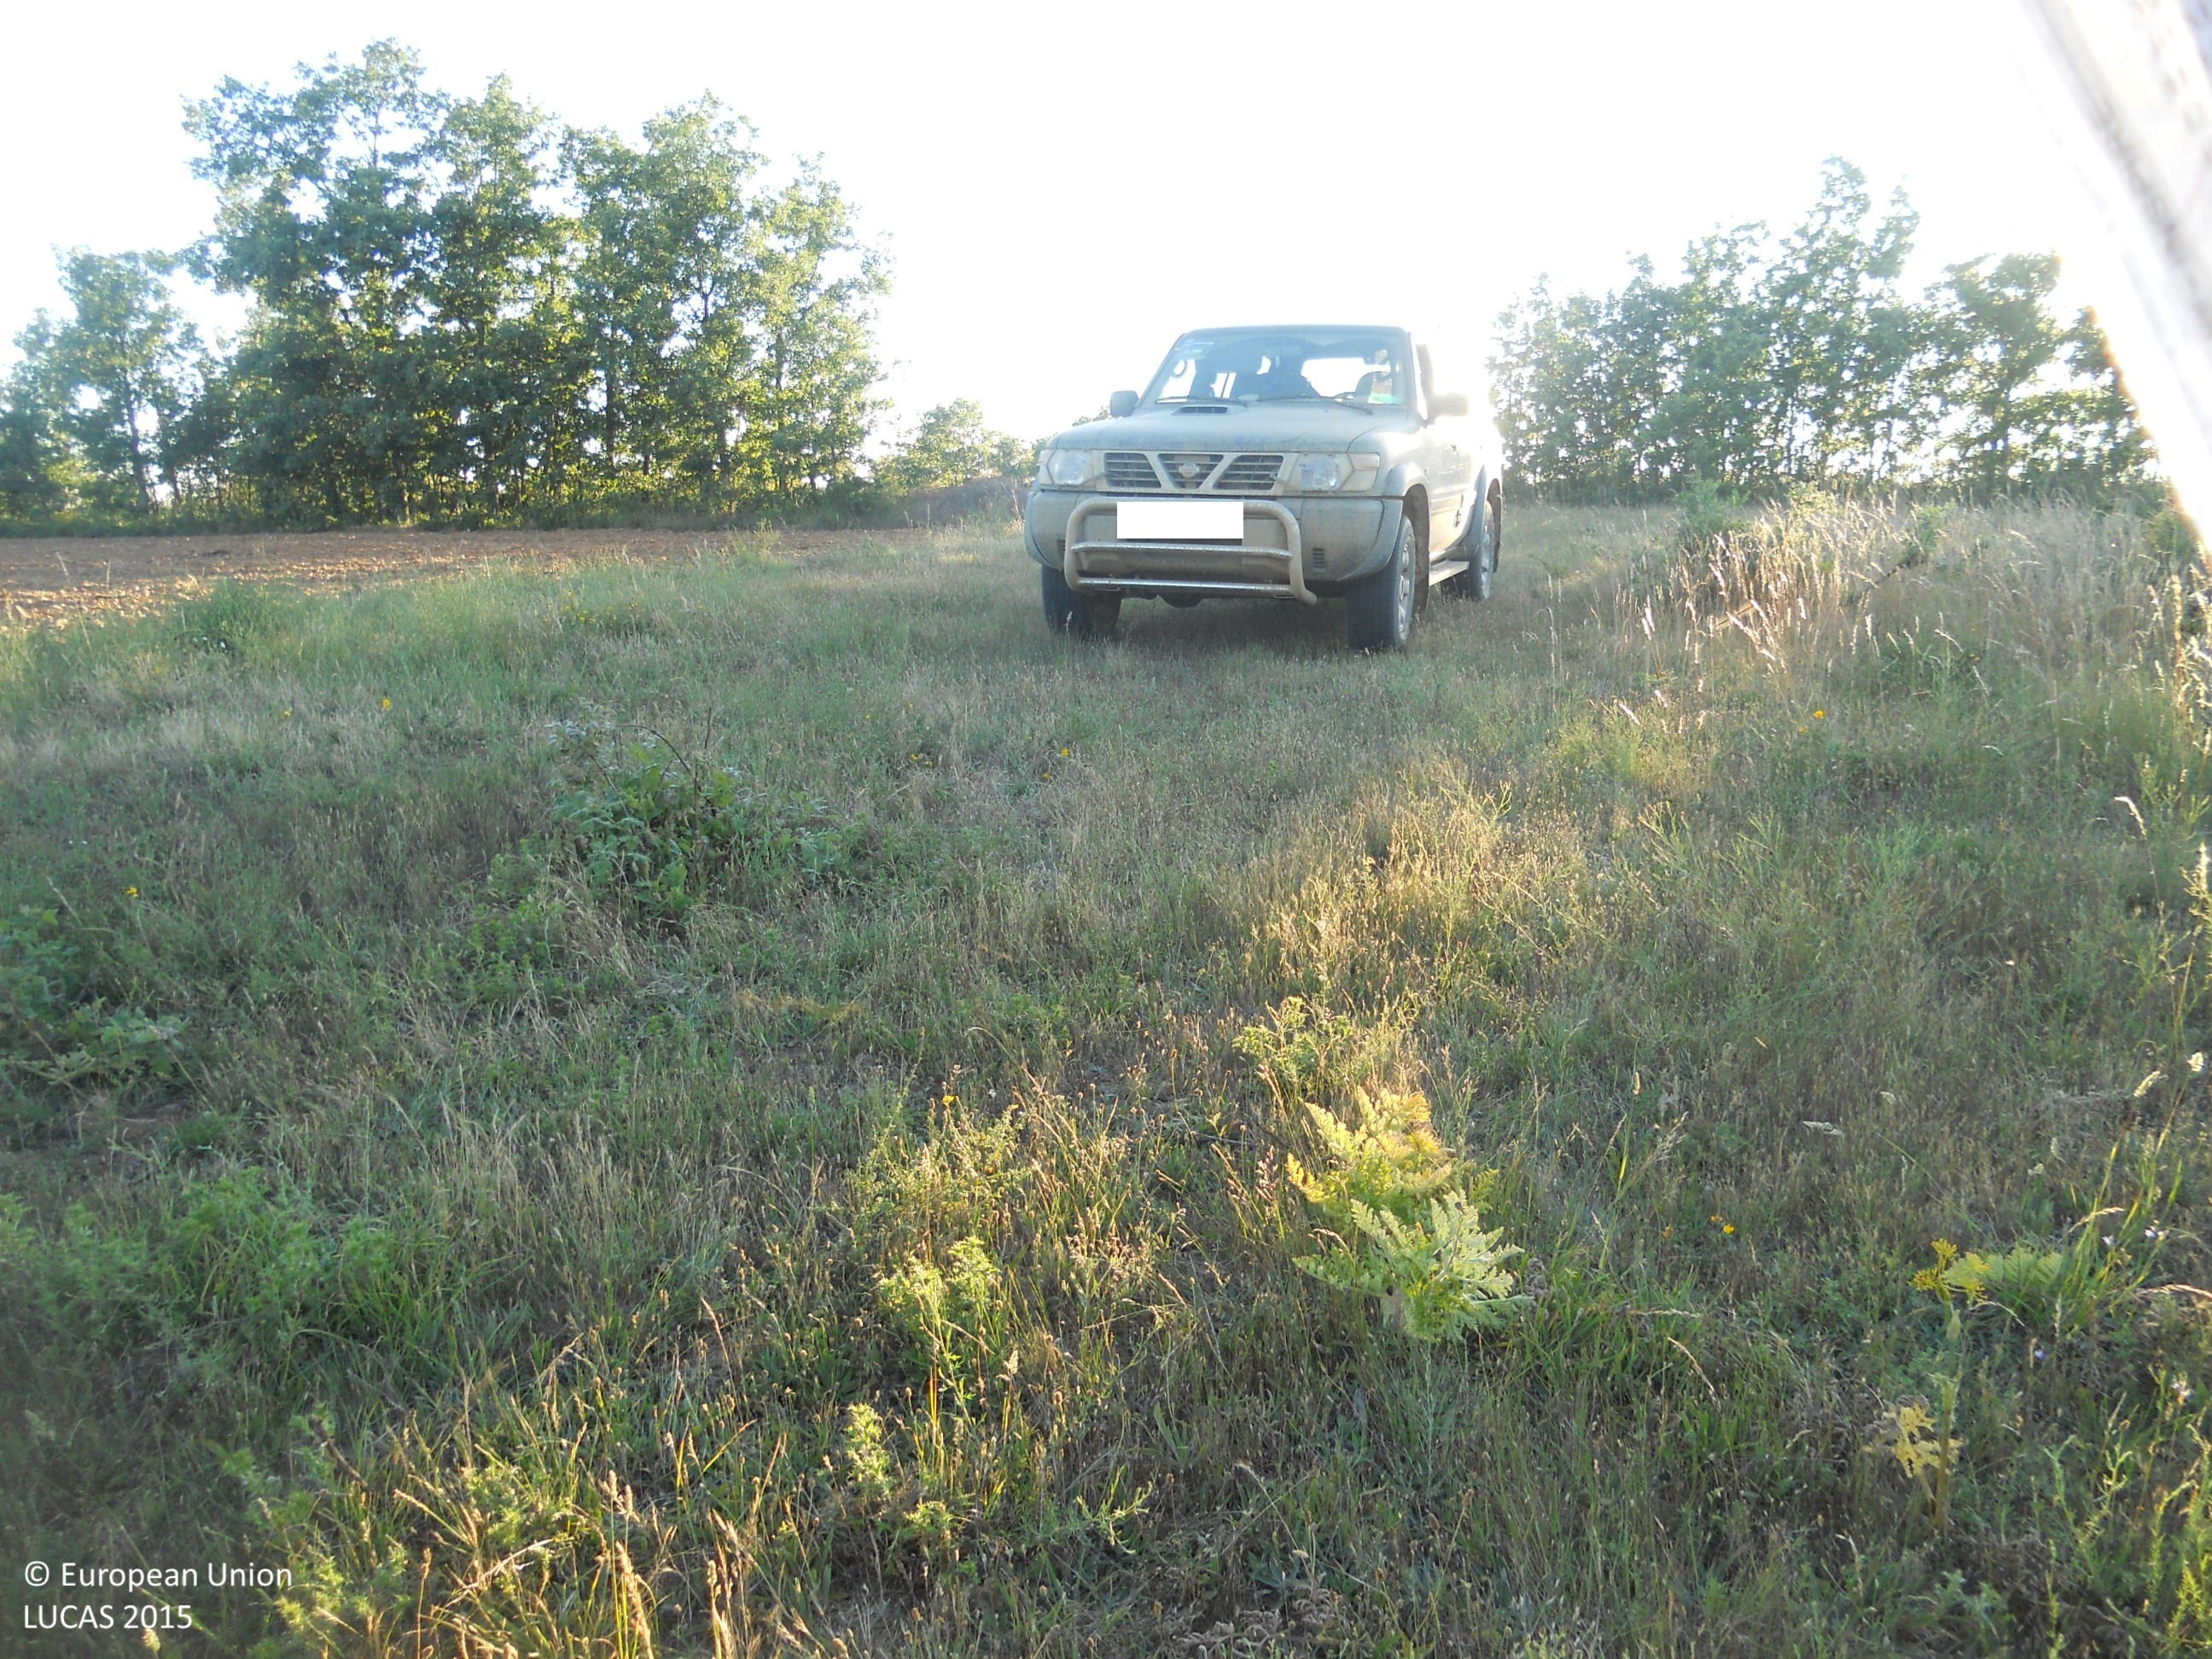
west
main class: Grassland
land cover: Grassland with sparse tree/shrub cover
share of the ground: > 75 %
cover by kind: herbaceous plants 65 %, unconsolidated bare surface 20 %, shrubs 10 %, broadleaved forest trees 5 %
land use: Semi-natural and natural areas not in use
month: June
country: ES
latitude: 42.5347
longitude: -4.9004
